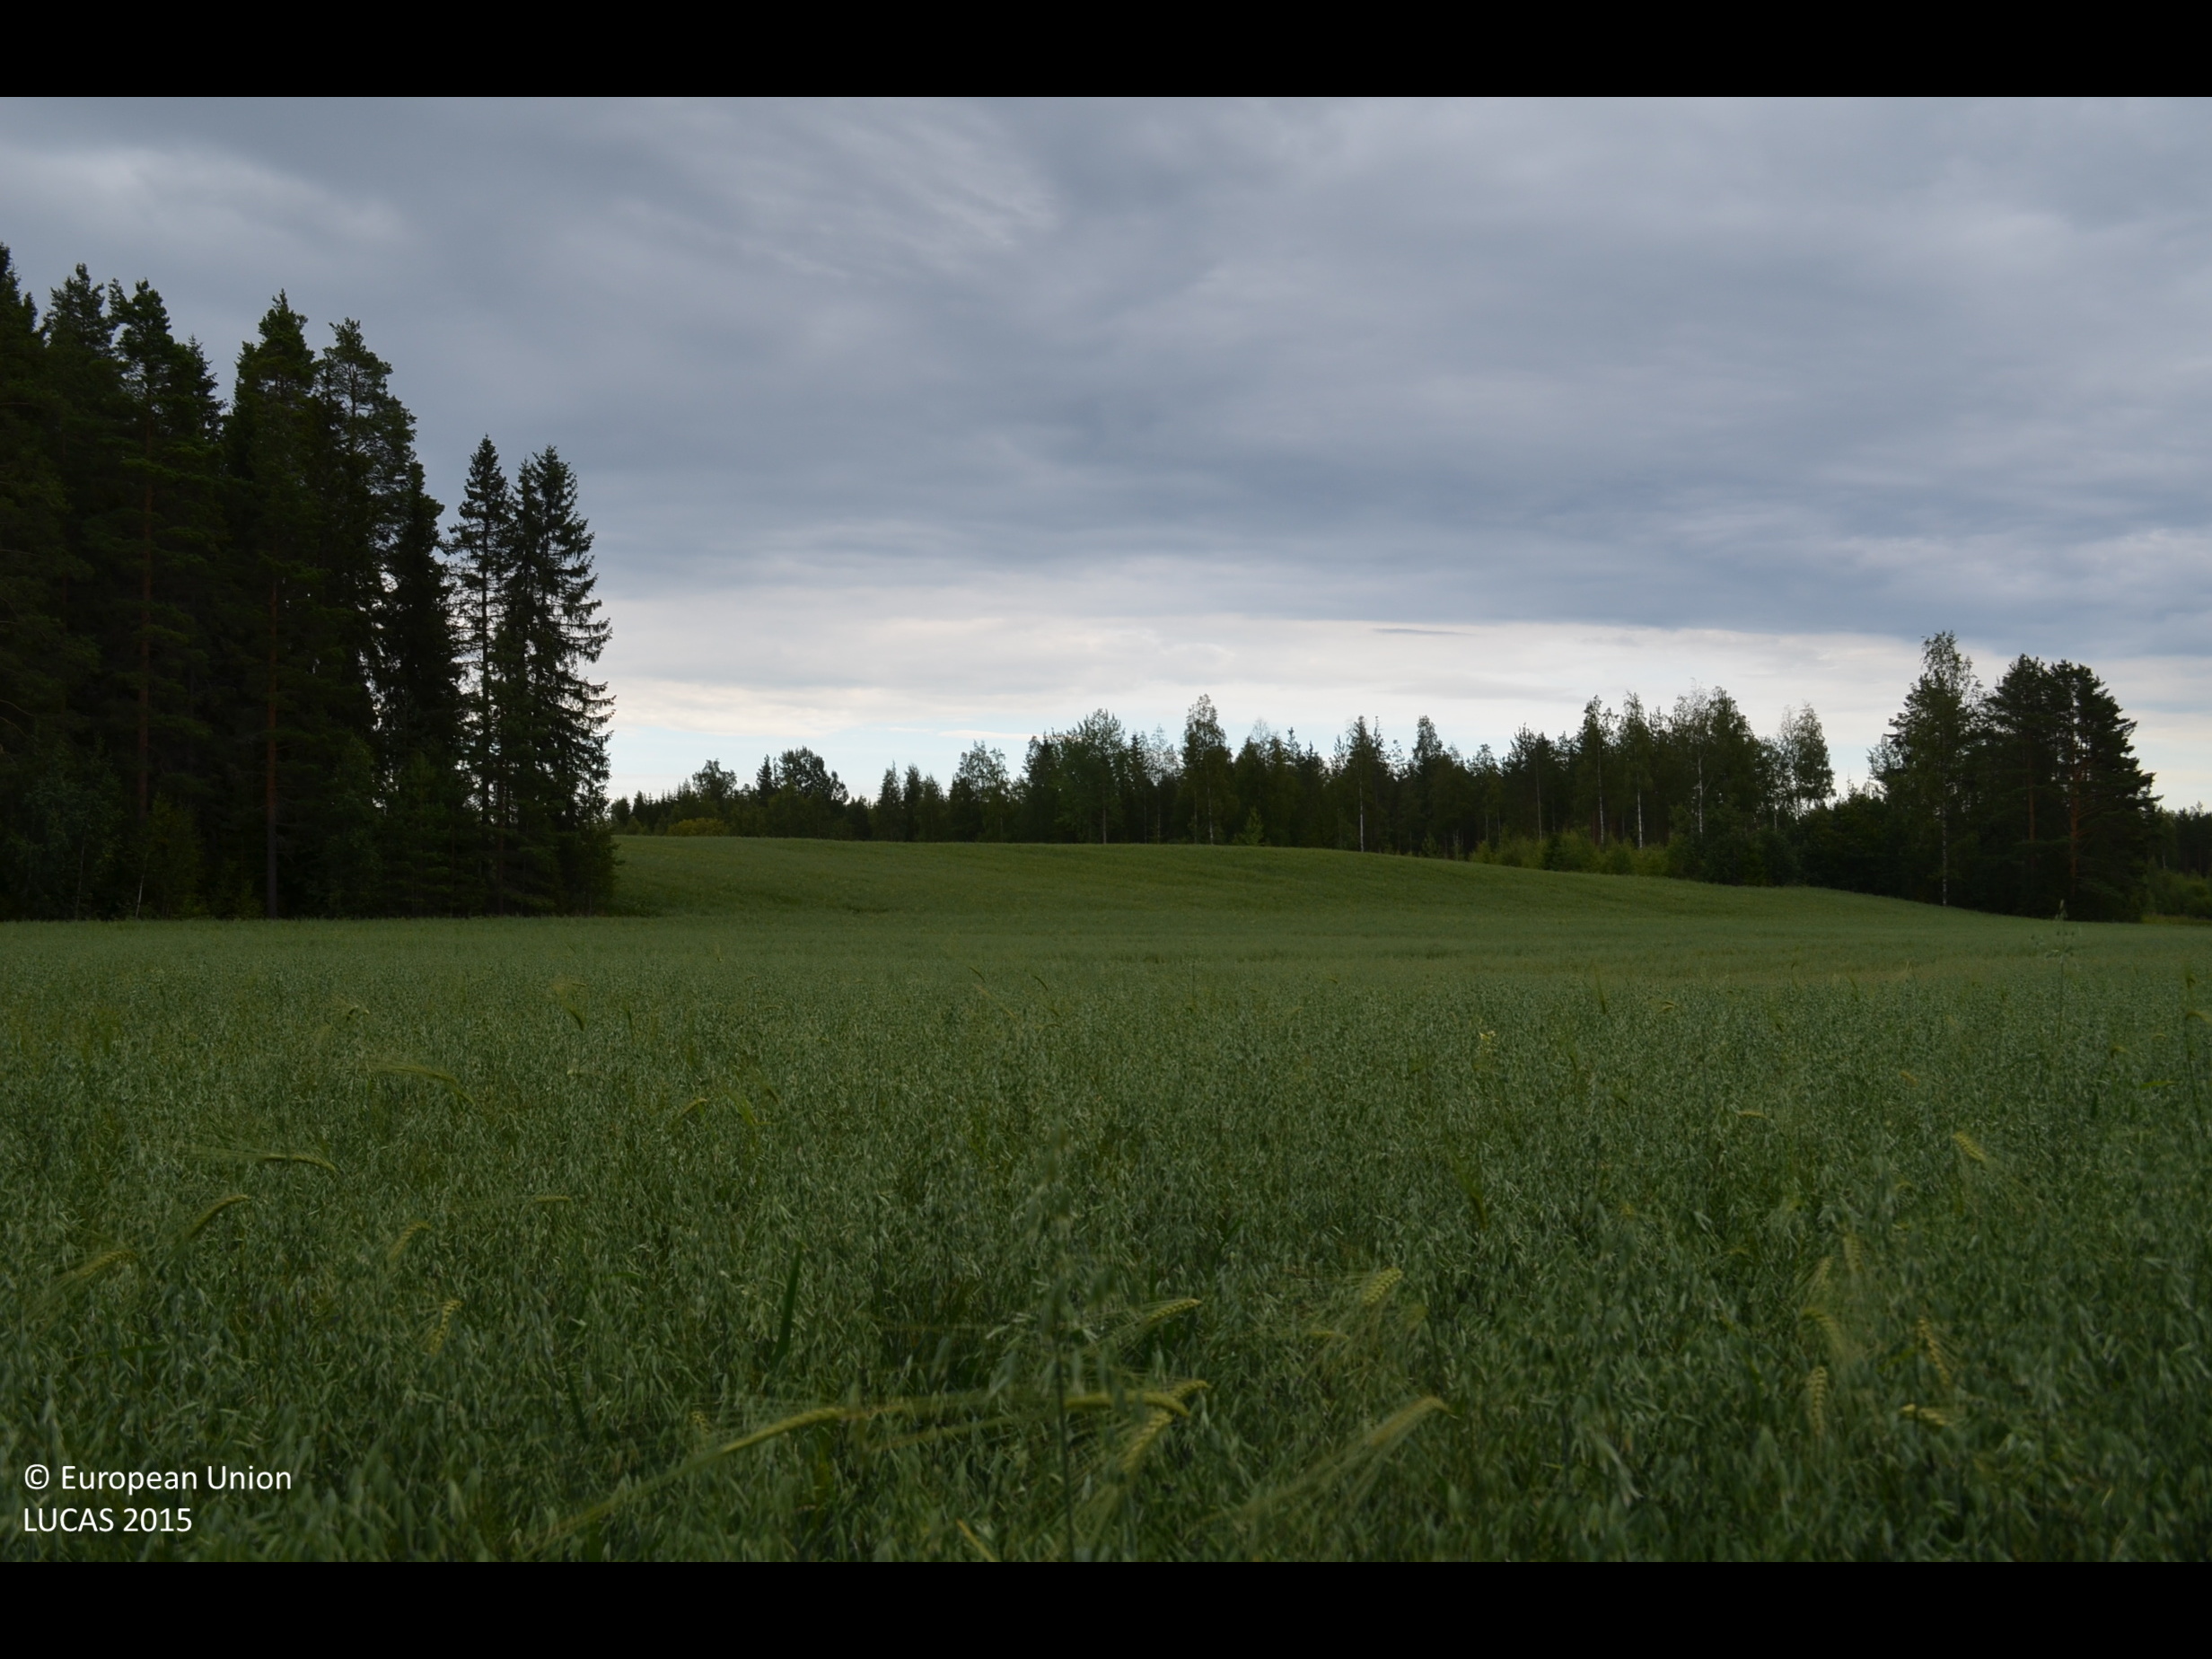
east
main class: Cropland
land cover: Mixed cereals for fodder
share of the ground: > 75 %
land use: Agriculture (excluding fallow land and kitchen gardens)
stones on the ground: < 10 %
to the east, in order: Mixed cereals for fodder; Grass margins; Ditches and canals; Spruce dominated mixed woodland
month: August
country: FI
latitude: 61.5668
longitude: 23.2345
